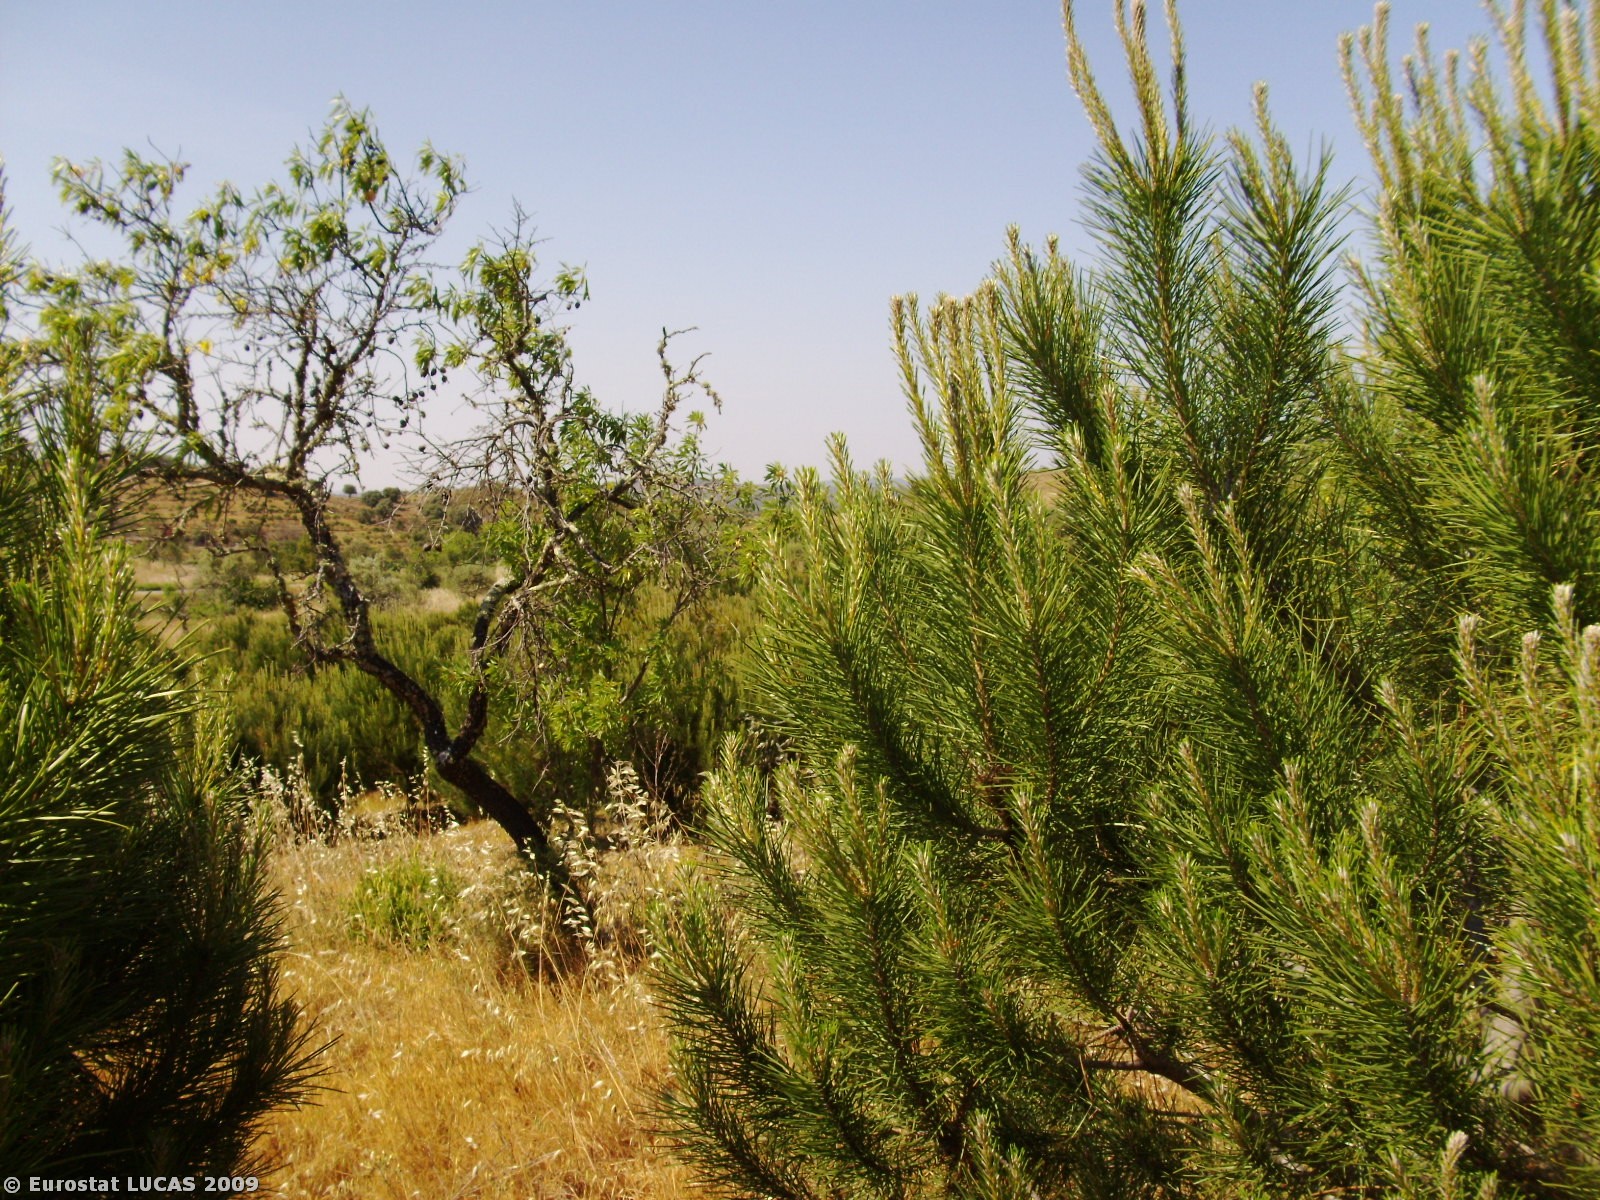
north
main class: Woodland
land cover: Coniferous woodland
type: coniferous forest of the mediterranean region
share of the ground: 10 - 25 %
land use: Forestry
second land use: Unused
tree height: > 5 m
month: May
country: PT
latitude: 37.4439
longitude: -7.4938
